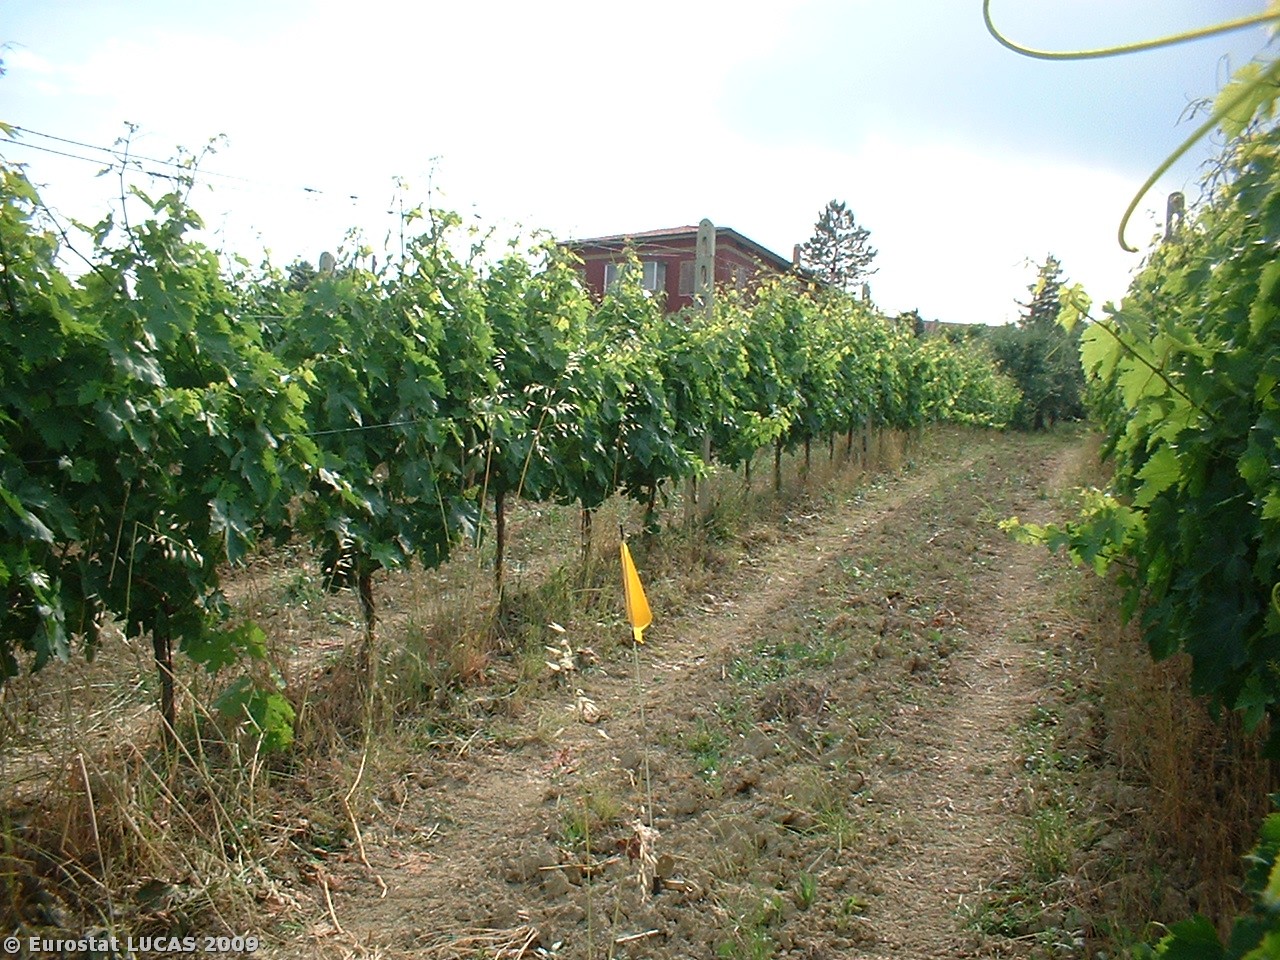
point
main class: Cropland
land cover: Vineyards
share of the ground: 25 - 50 %
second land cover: Bare land
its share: > 75 %
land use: Agriculture (excluding fallow land and kitchen gardens)
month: June
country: IT
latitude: 42.9289
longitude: 13.7268
